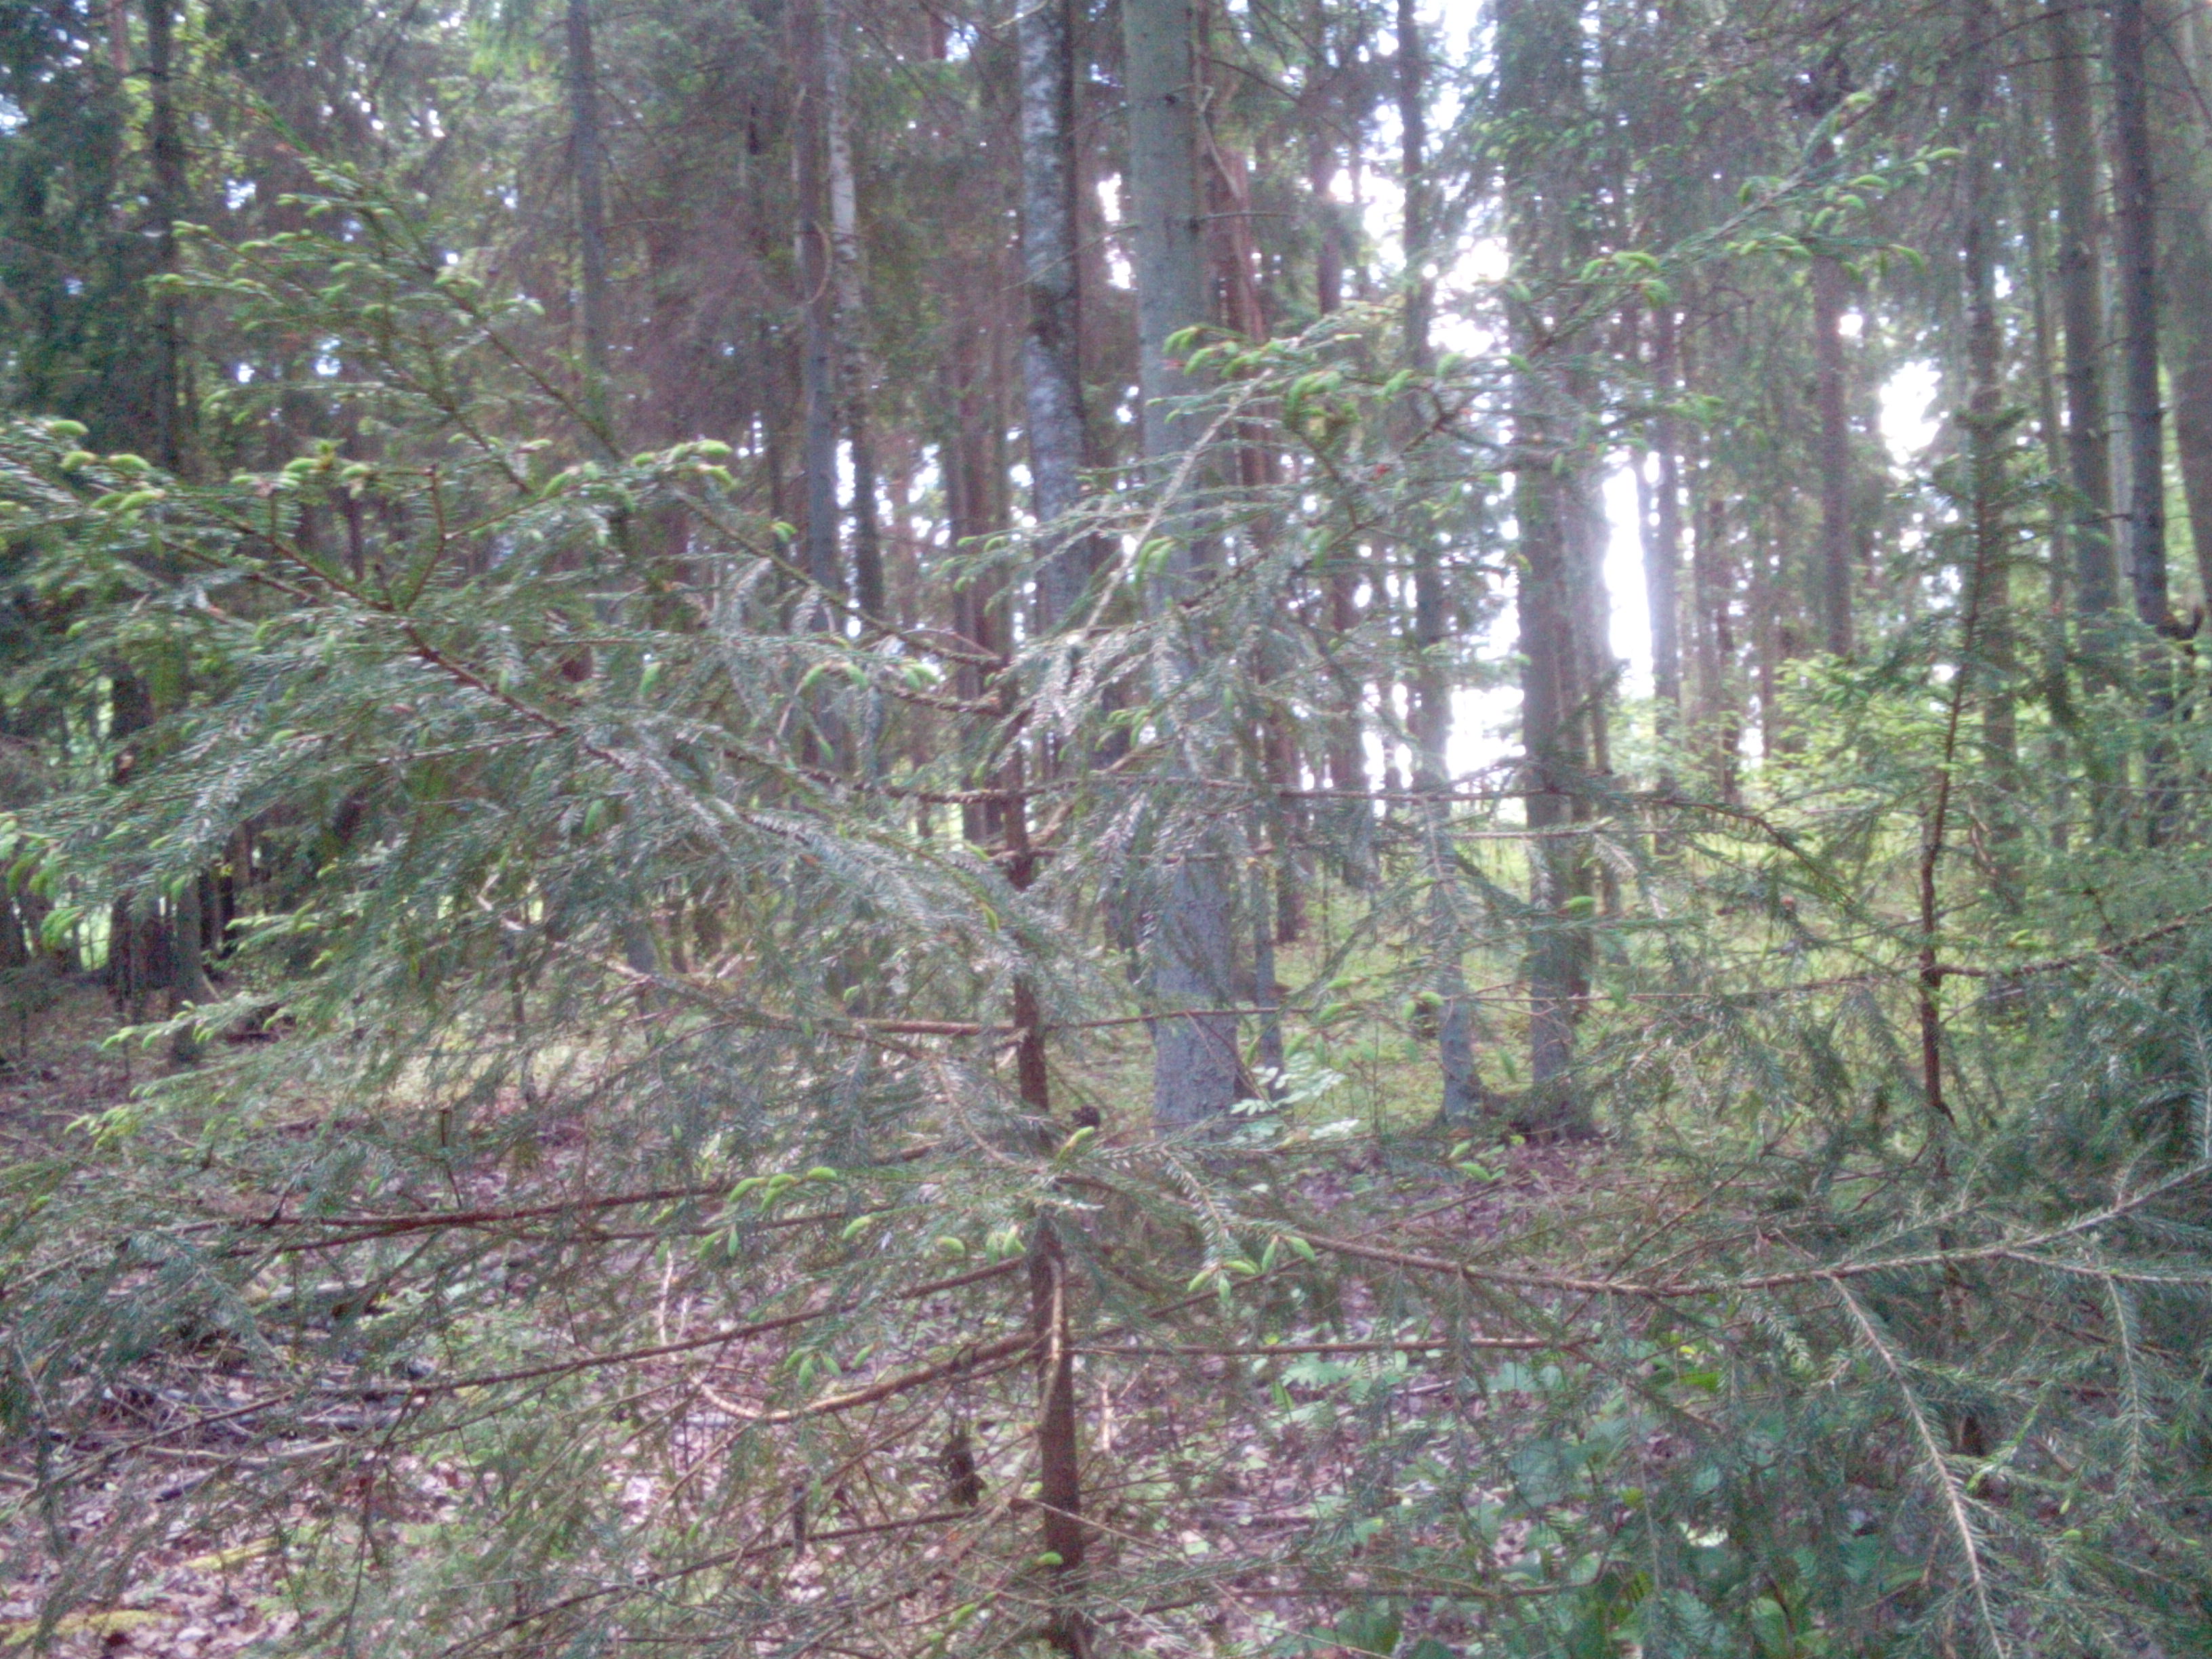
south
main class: Woodland
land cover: Spruce dominated mixed woodland
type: hemiboreal forest and nemoral coniferous forest and mixed broadleaved-coniferous forest
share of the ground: > 75 %
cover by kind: broadleaved forest trees 50 %, coniferous forest trees 40 %, herbaceous plants 10 %
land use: Forestry
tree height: > 5 m
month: June
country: LV
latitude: 56.6733
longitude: 22.2433
